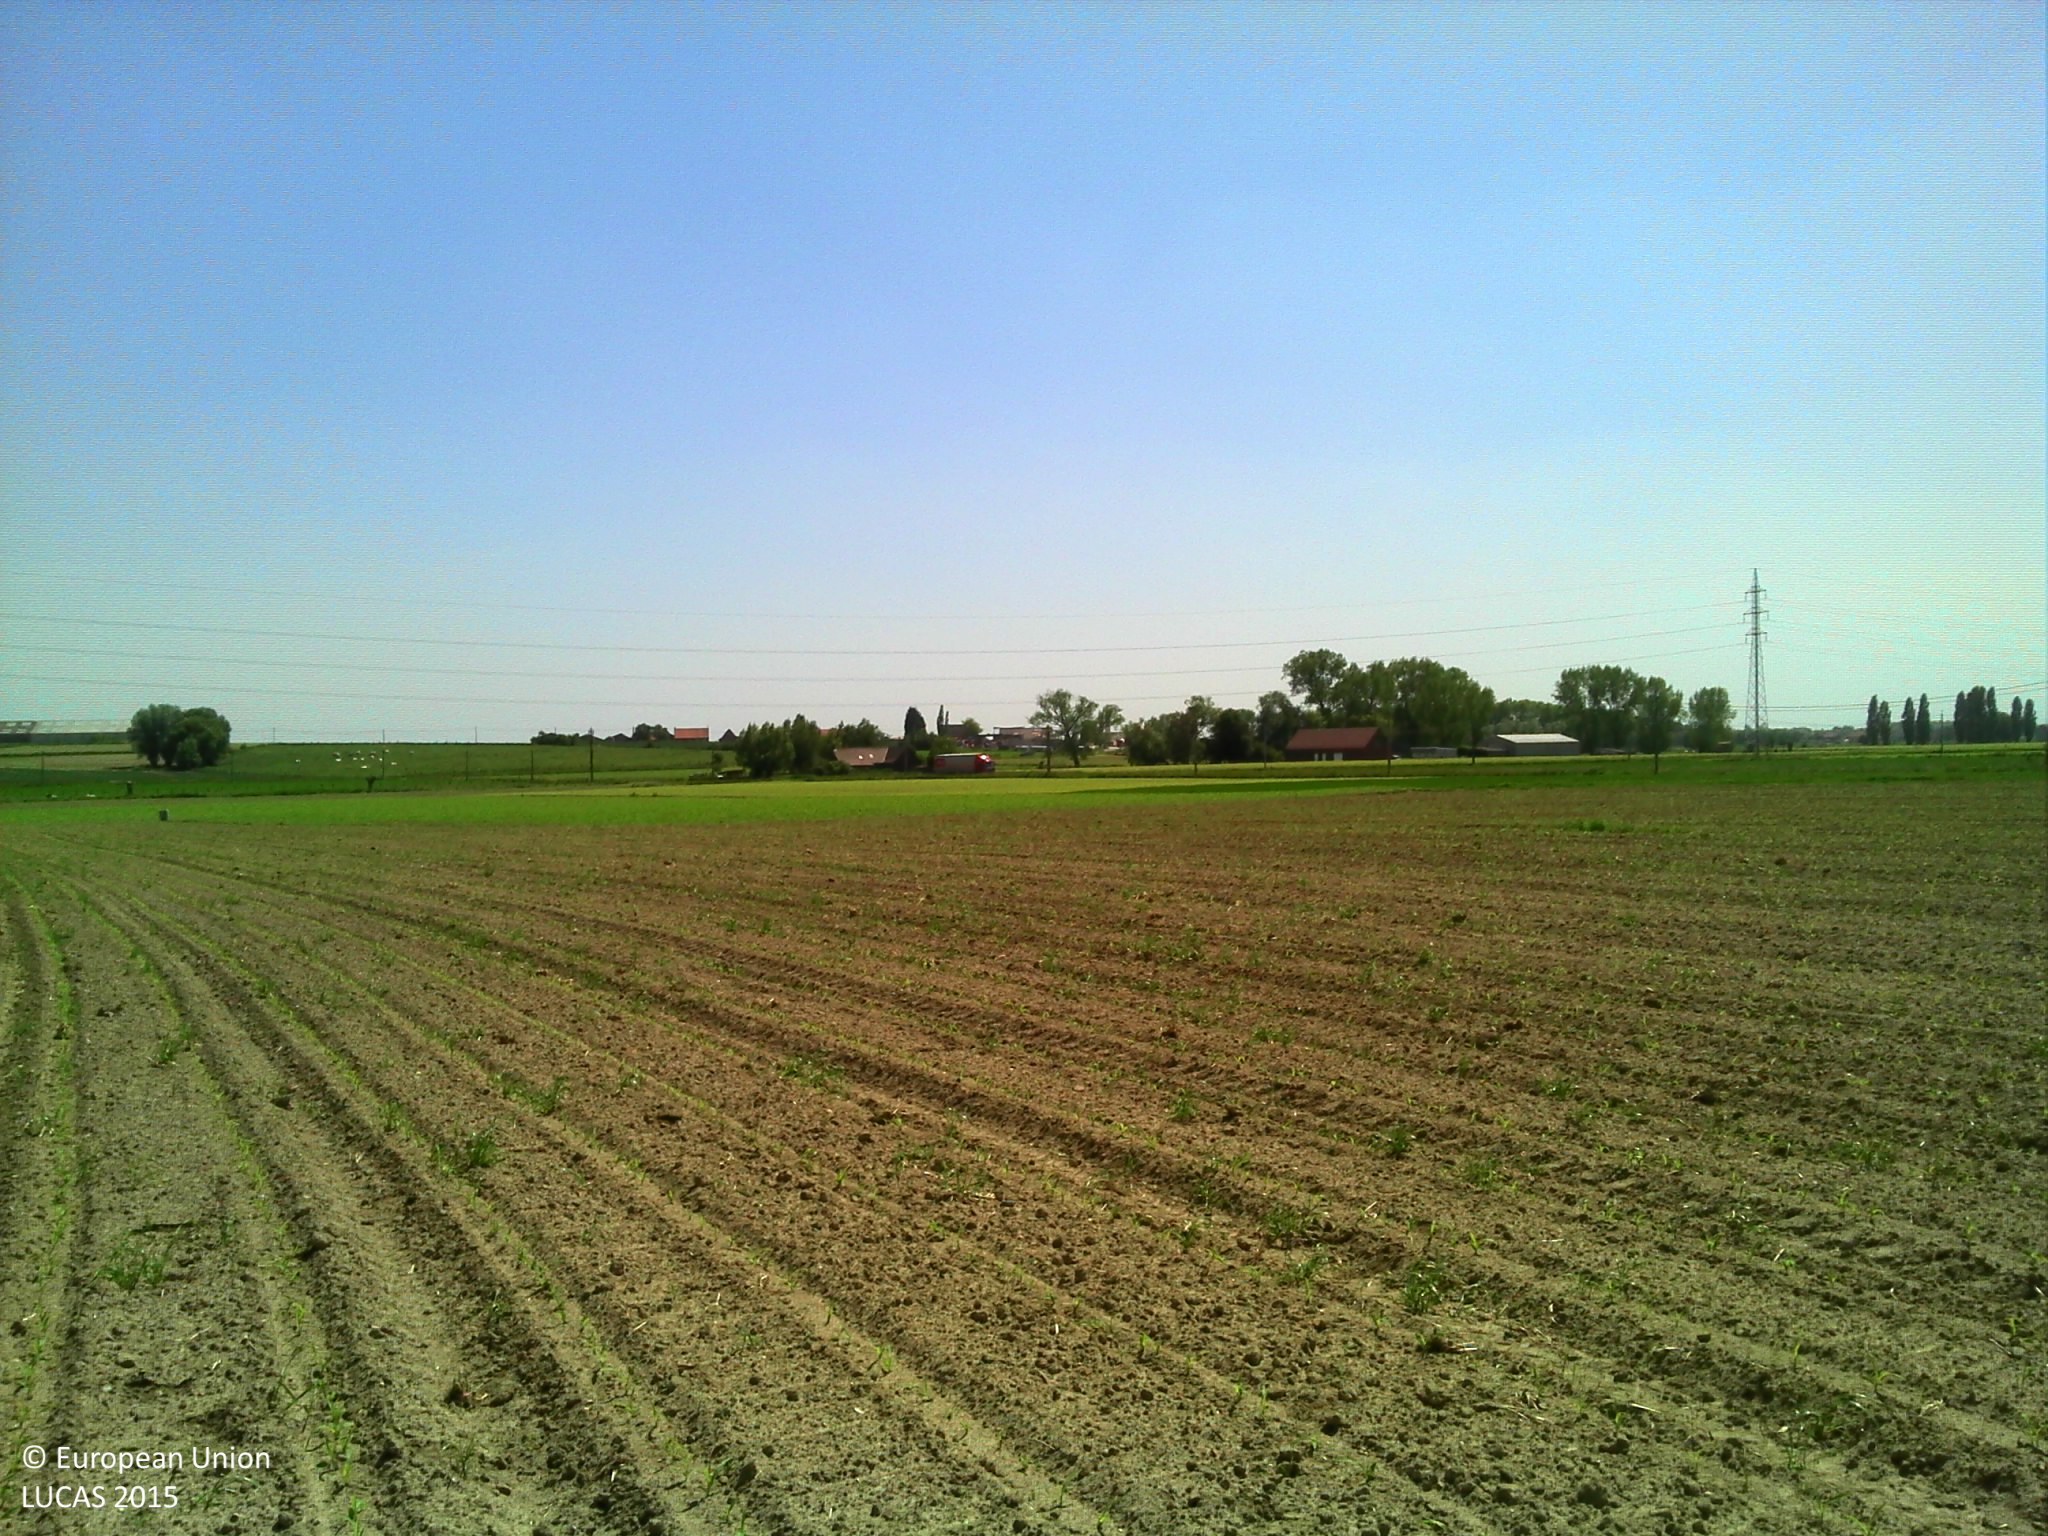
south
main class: Cropland
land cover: Maize
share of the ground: 10 - 25 %
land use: Agriculture (excluding fallow land and kitchen gardens)
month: June
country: BE
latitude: 50.8151
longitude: 2.9641
